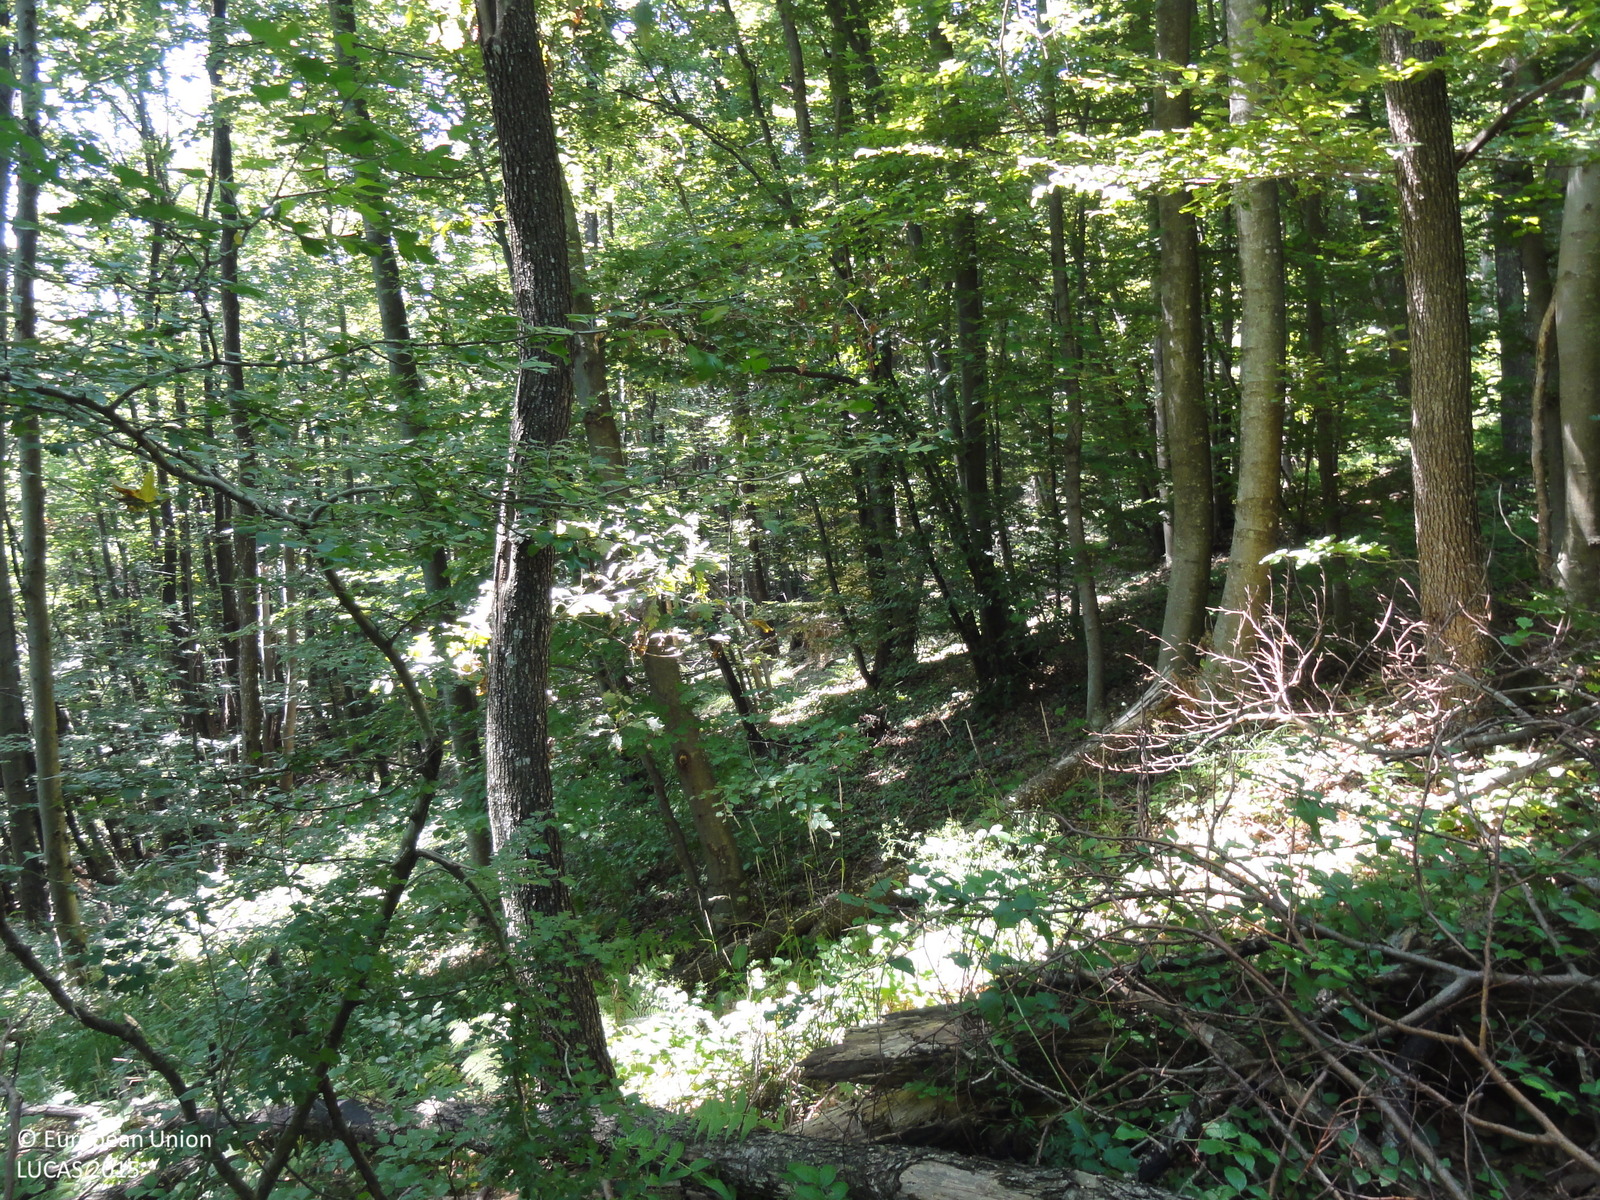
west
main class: Woodland
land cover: Broadleaved woodland
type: beech forest
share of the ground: > 75 %
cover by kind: broadleaved forest trees 100 %
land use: Forestry
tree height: > 5 m
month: August
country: SI
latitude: 45.9988
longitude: 15.0197
